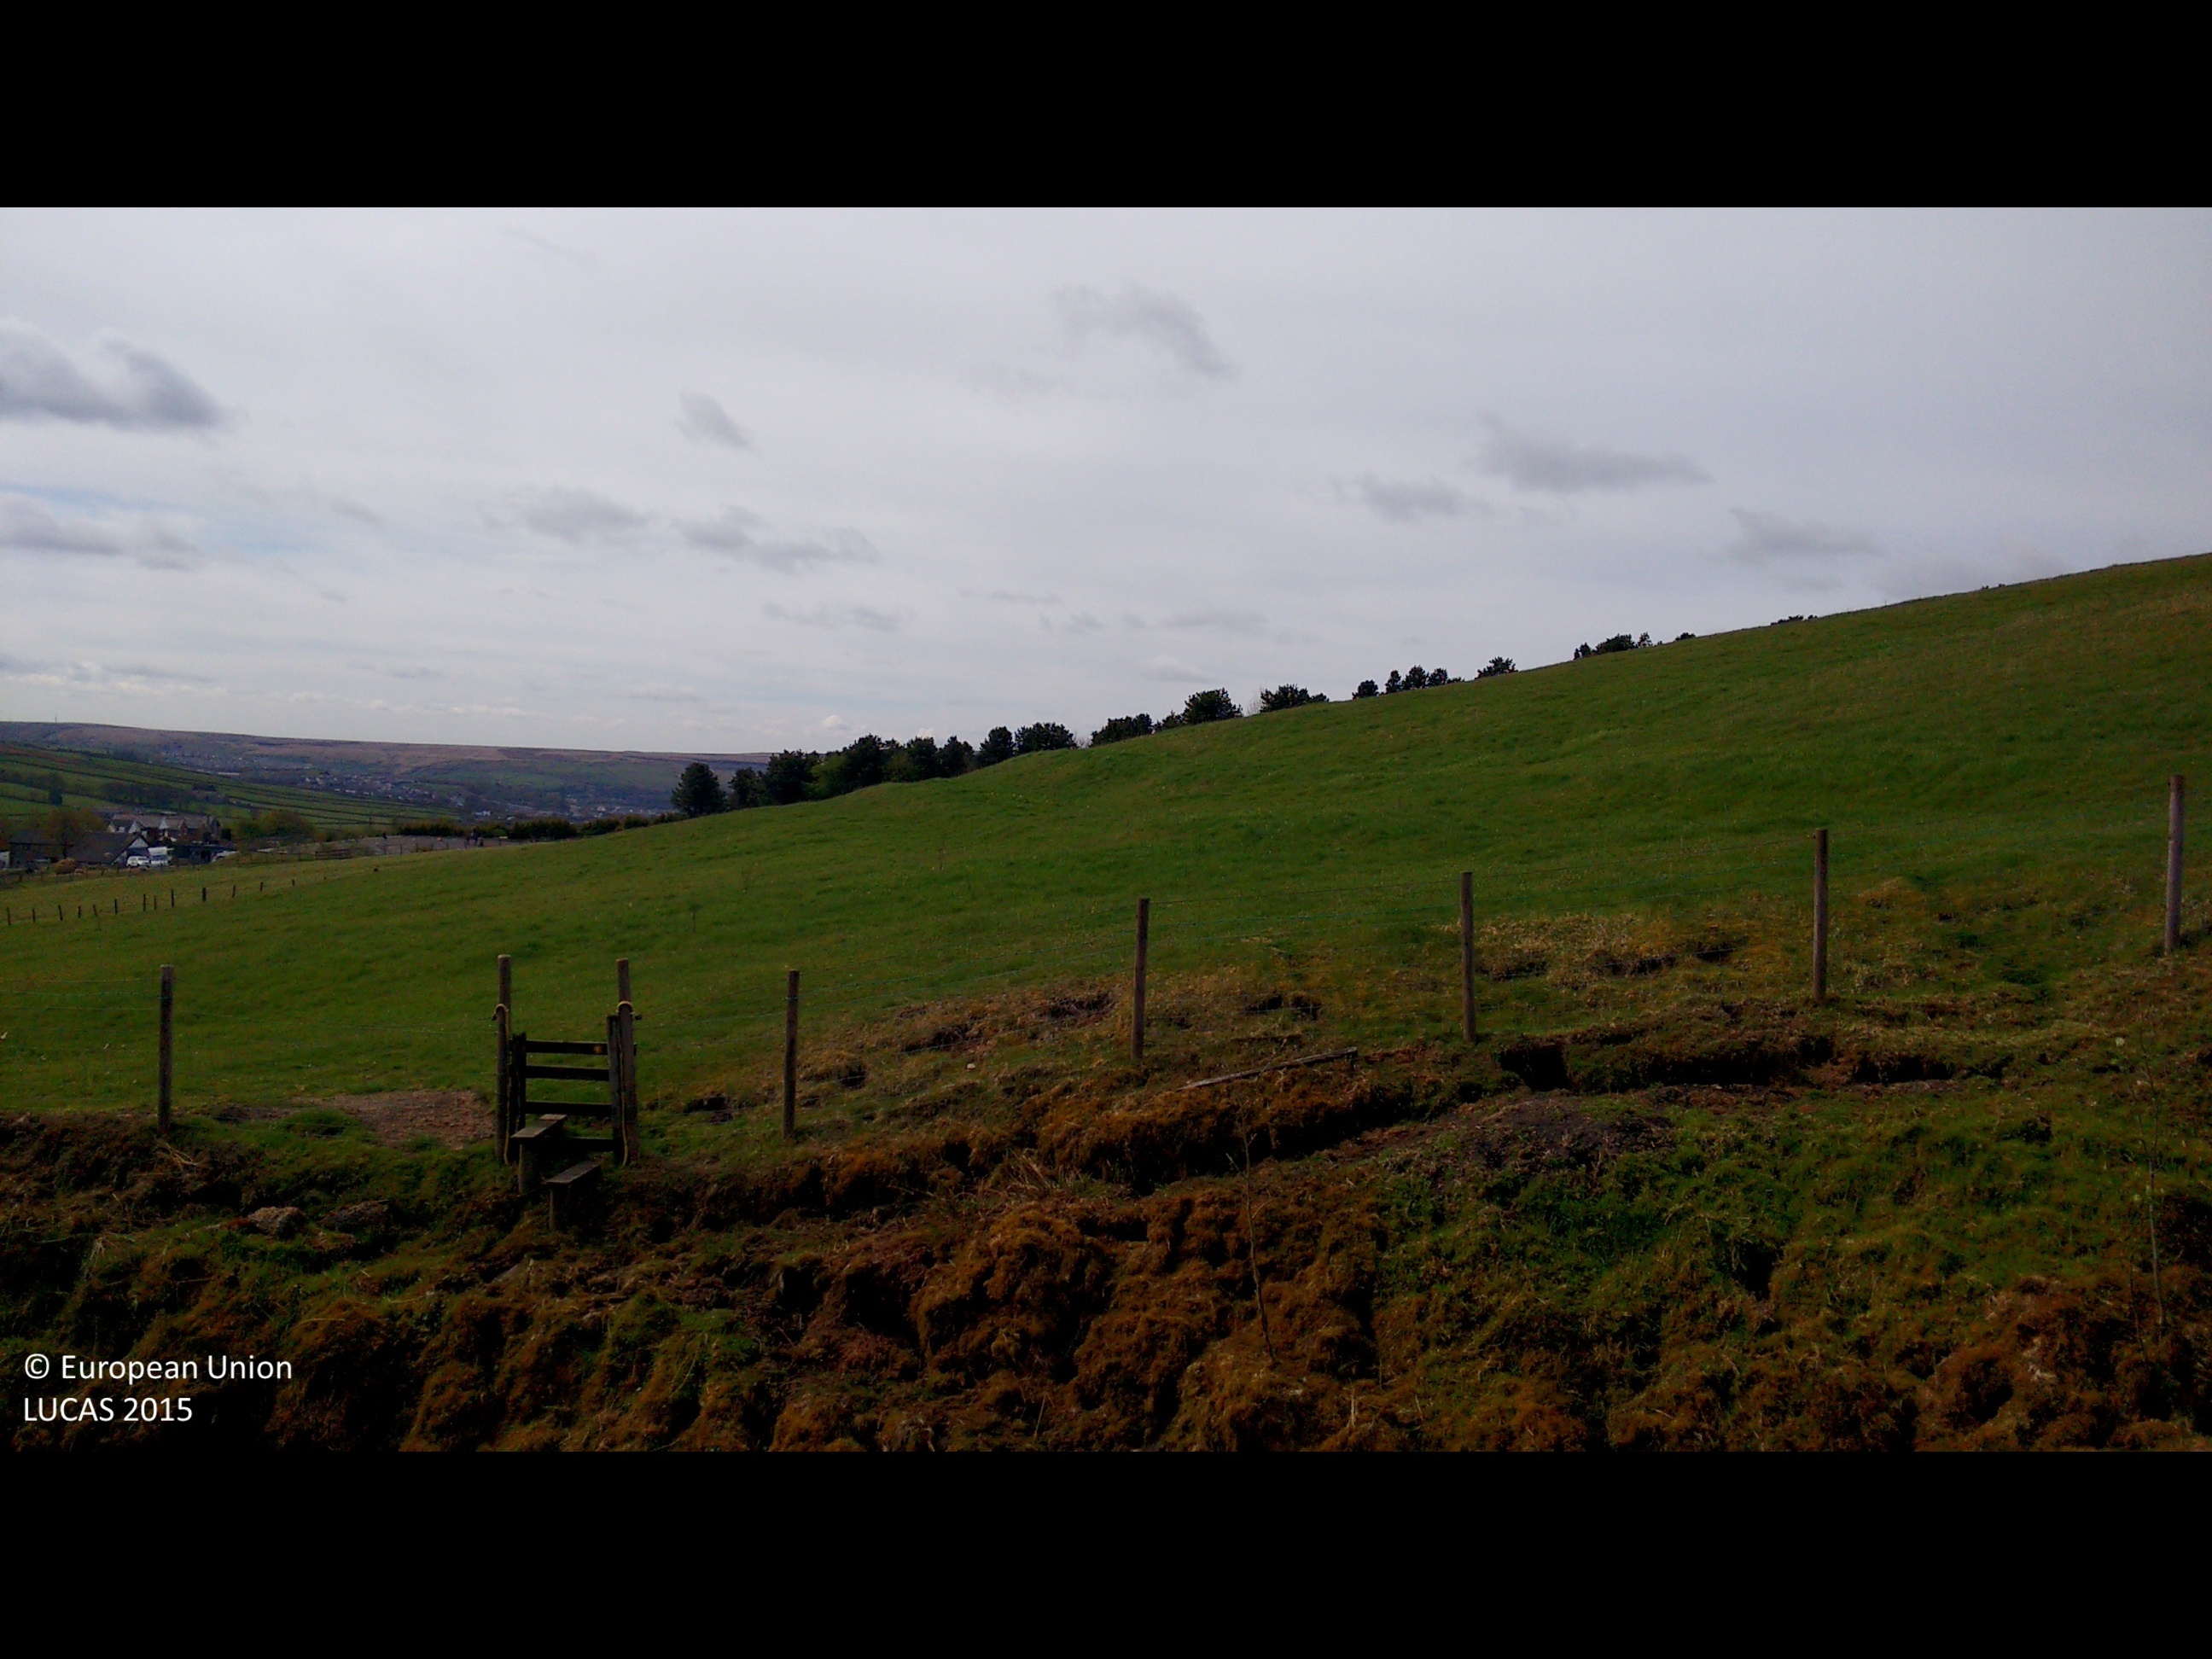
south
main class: Grassland
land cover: Grassland without tree/shrub cover
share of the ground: > 75 %
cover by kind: herbaceous plants 100 %
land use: Agriculture (excluding fallow land and kitchen gardens)
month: May
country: GB
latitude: 53.7282
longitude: -2.2011
